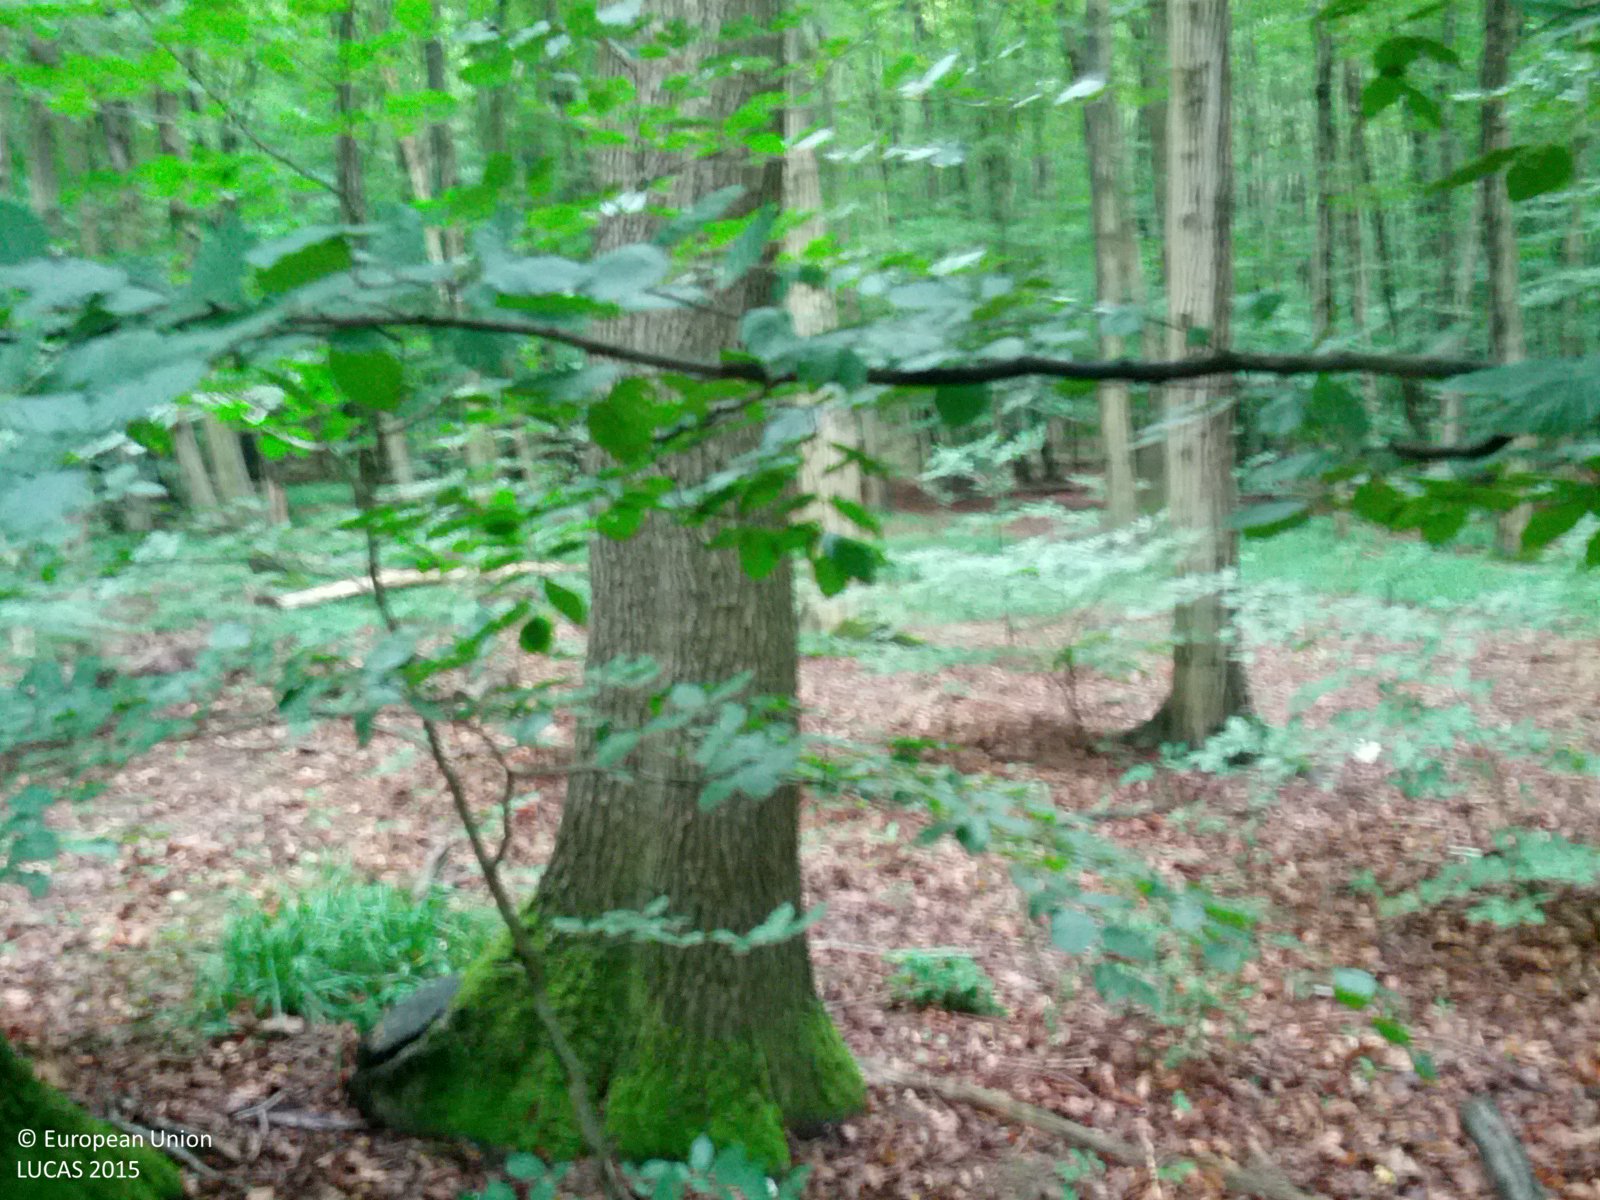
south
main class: Woodland
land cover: Broadleaved woodland
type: beech forest
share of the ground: > 75 %
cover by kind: broadleaved forest trees 90 %, herbaceous plants 10 %
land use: Forestry
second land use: Amenities, museums, leisure
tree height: > 5 m
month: June
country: AT
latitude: 48.2423
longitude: 16.2932
